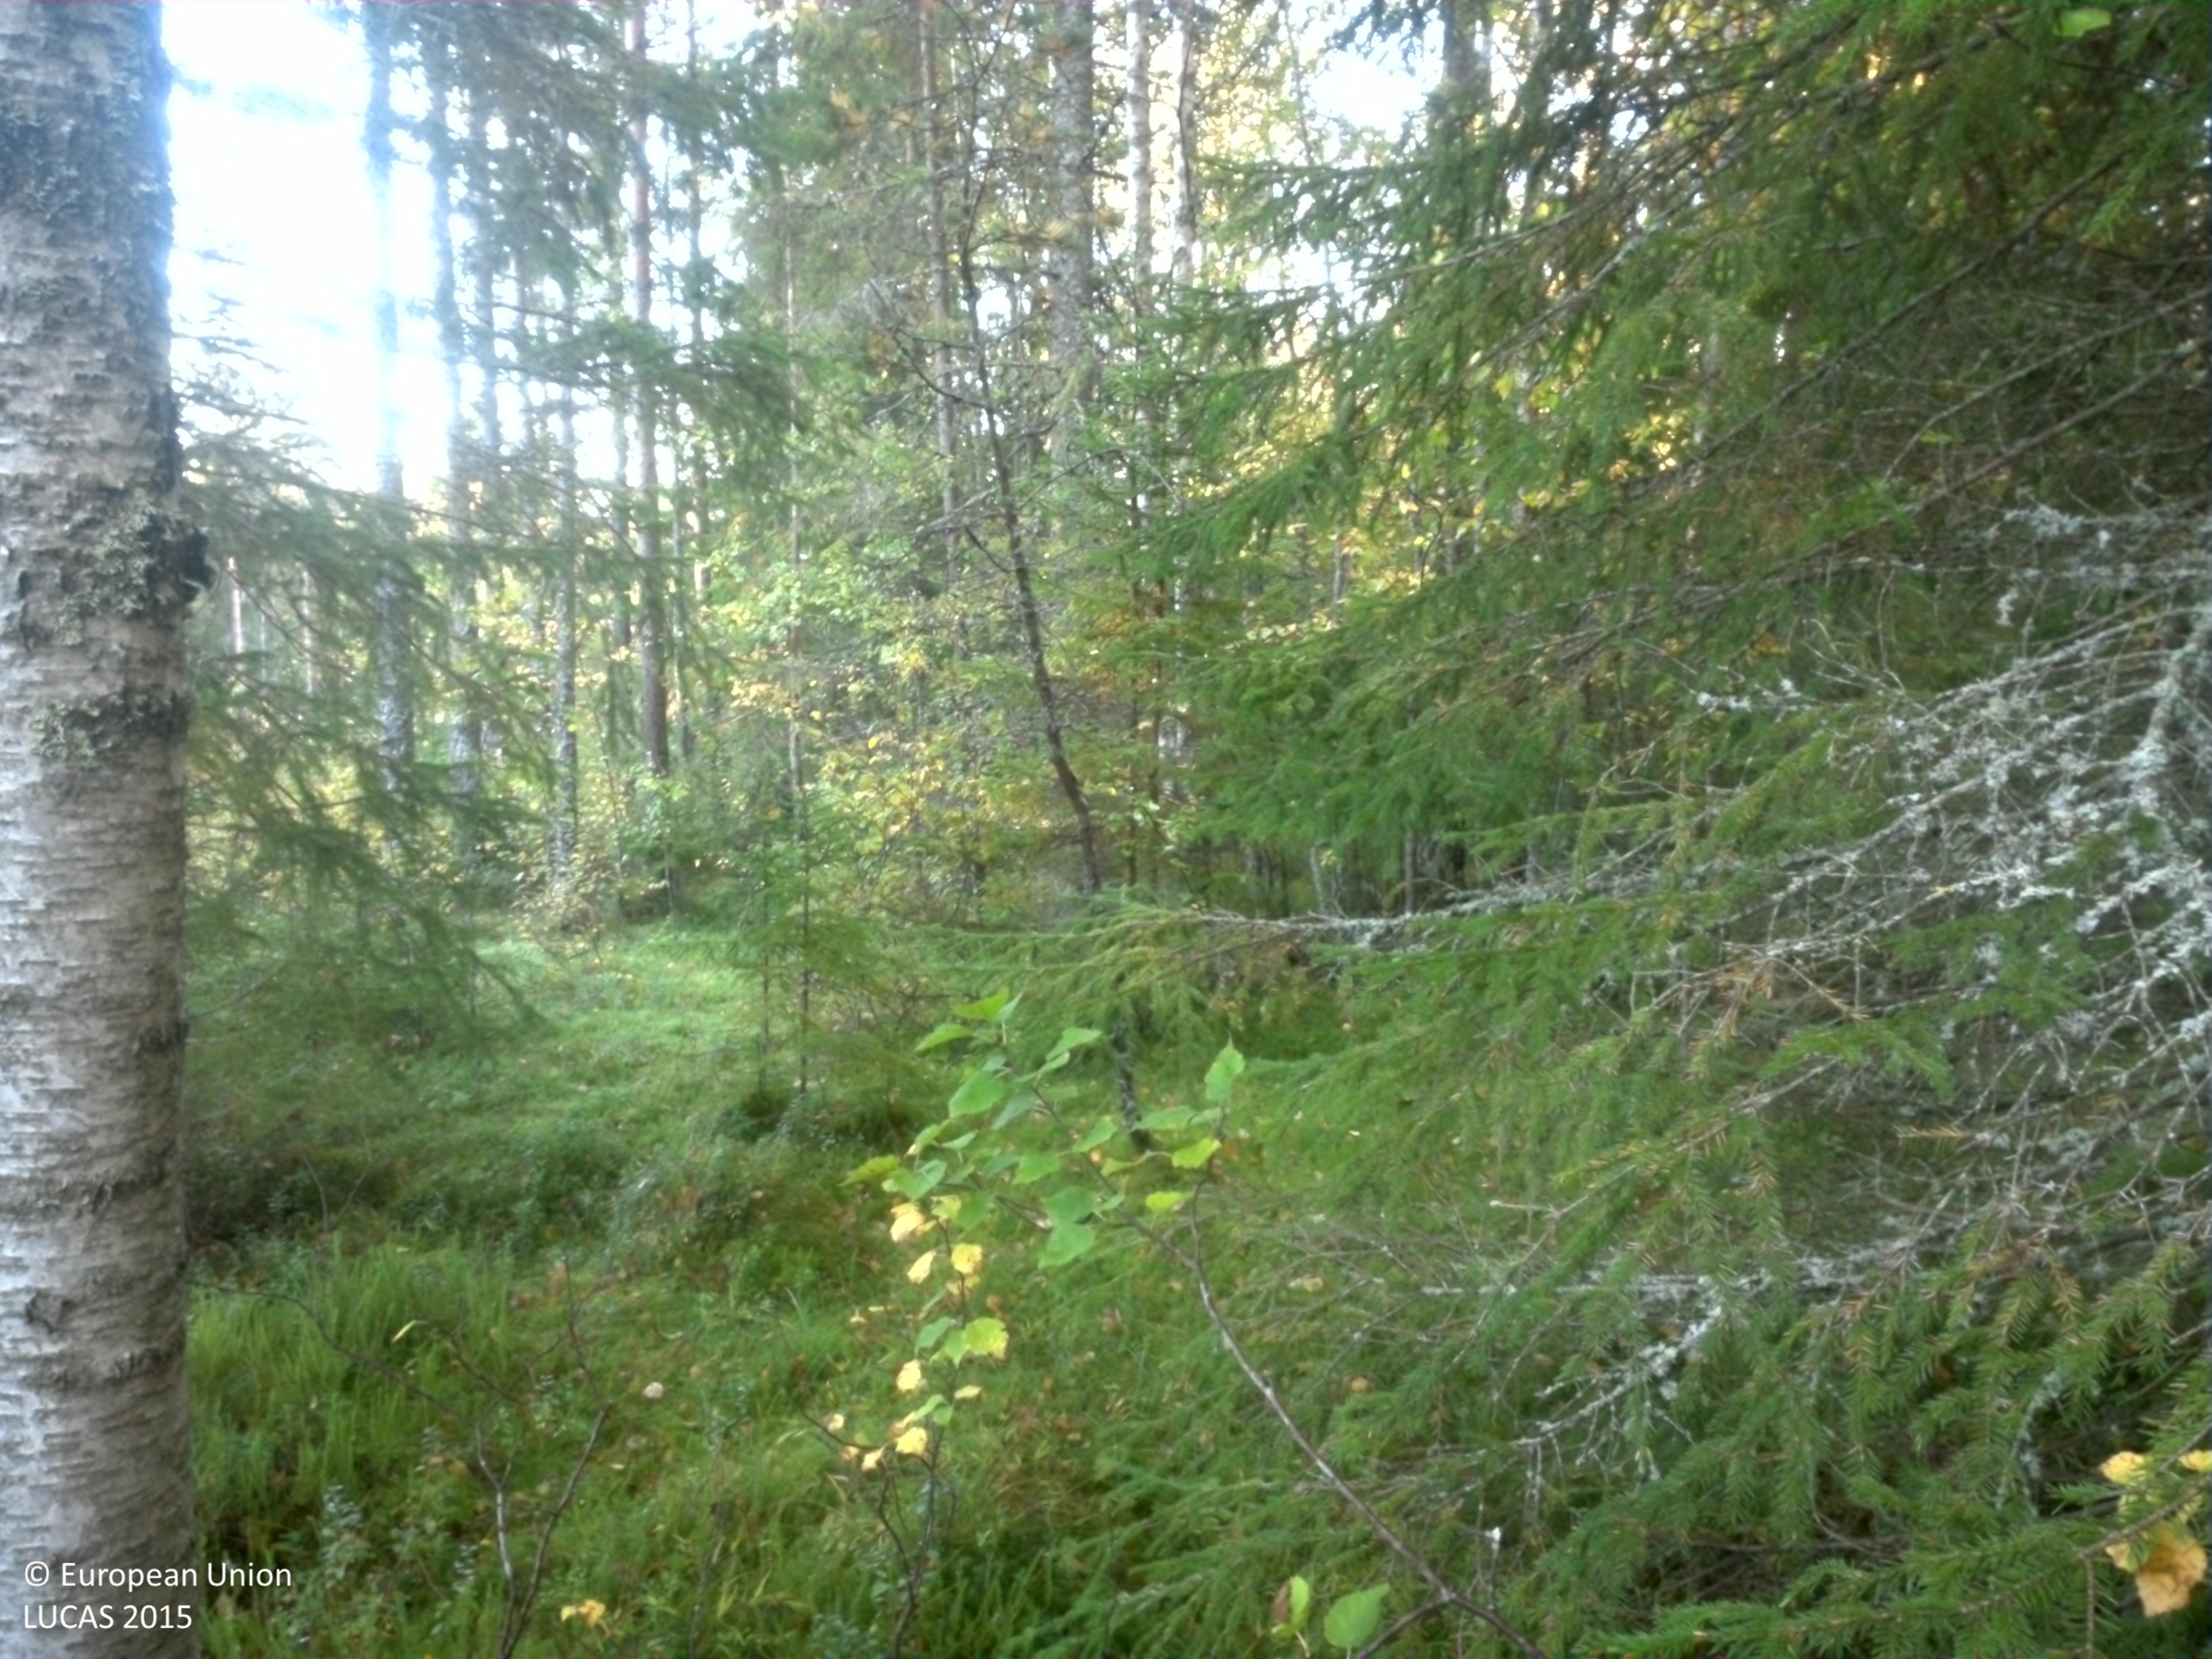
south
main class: Woodland
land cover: Pine dominated mixed woodland
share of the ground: > 75 %
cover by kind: coniferous forest trees 50 %, broadleaved forest trees 25 %, shrubs 10 %, lichens and mosses 10 %, herbaceous plants 5 %
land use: Forestry
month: September
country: SE
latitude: 59.9007
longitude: 15.2991
